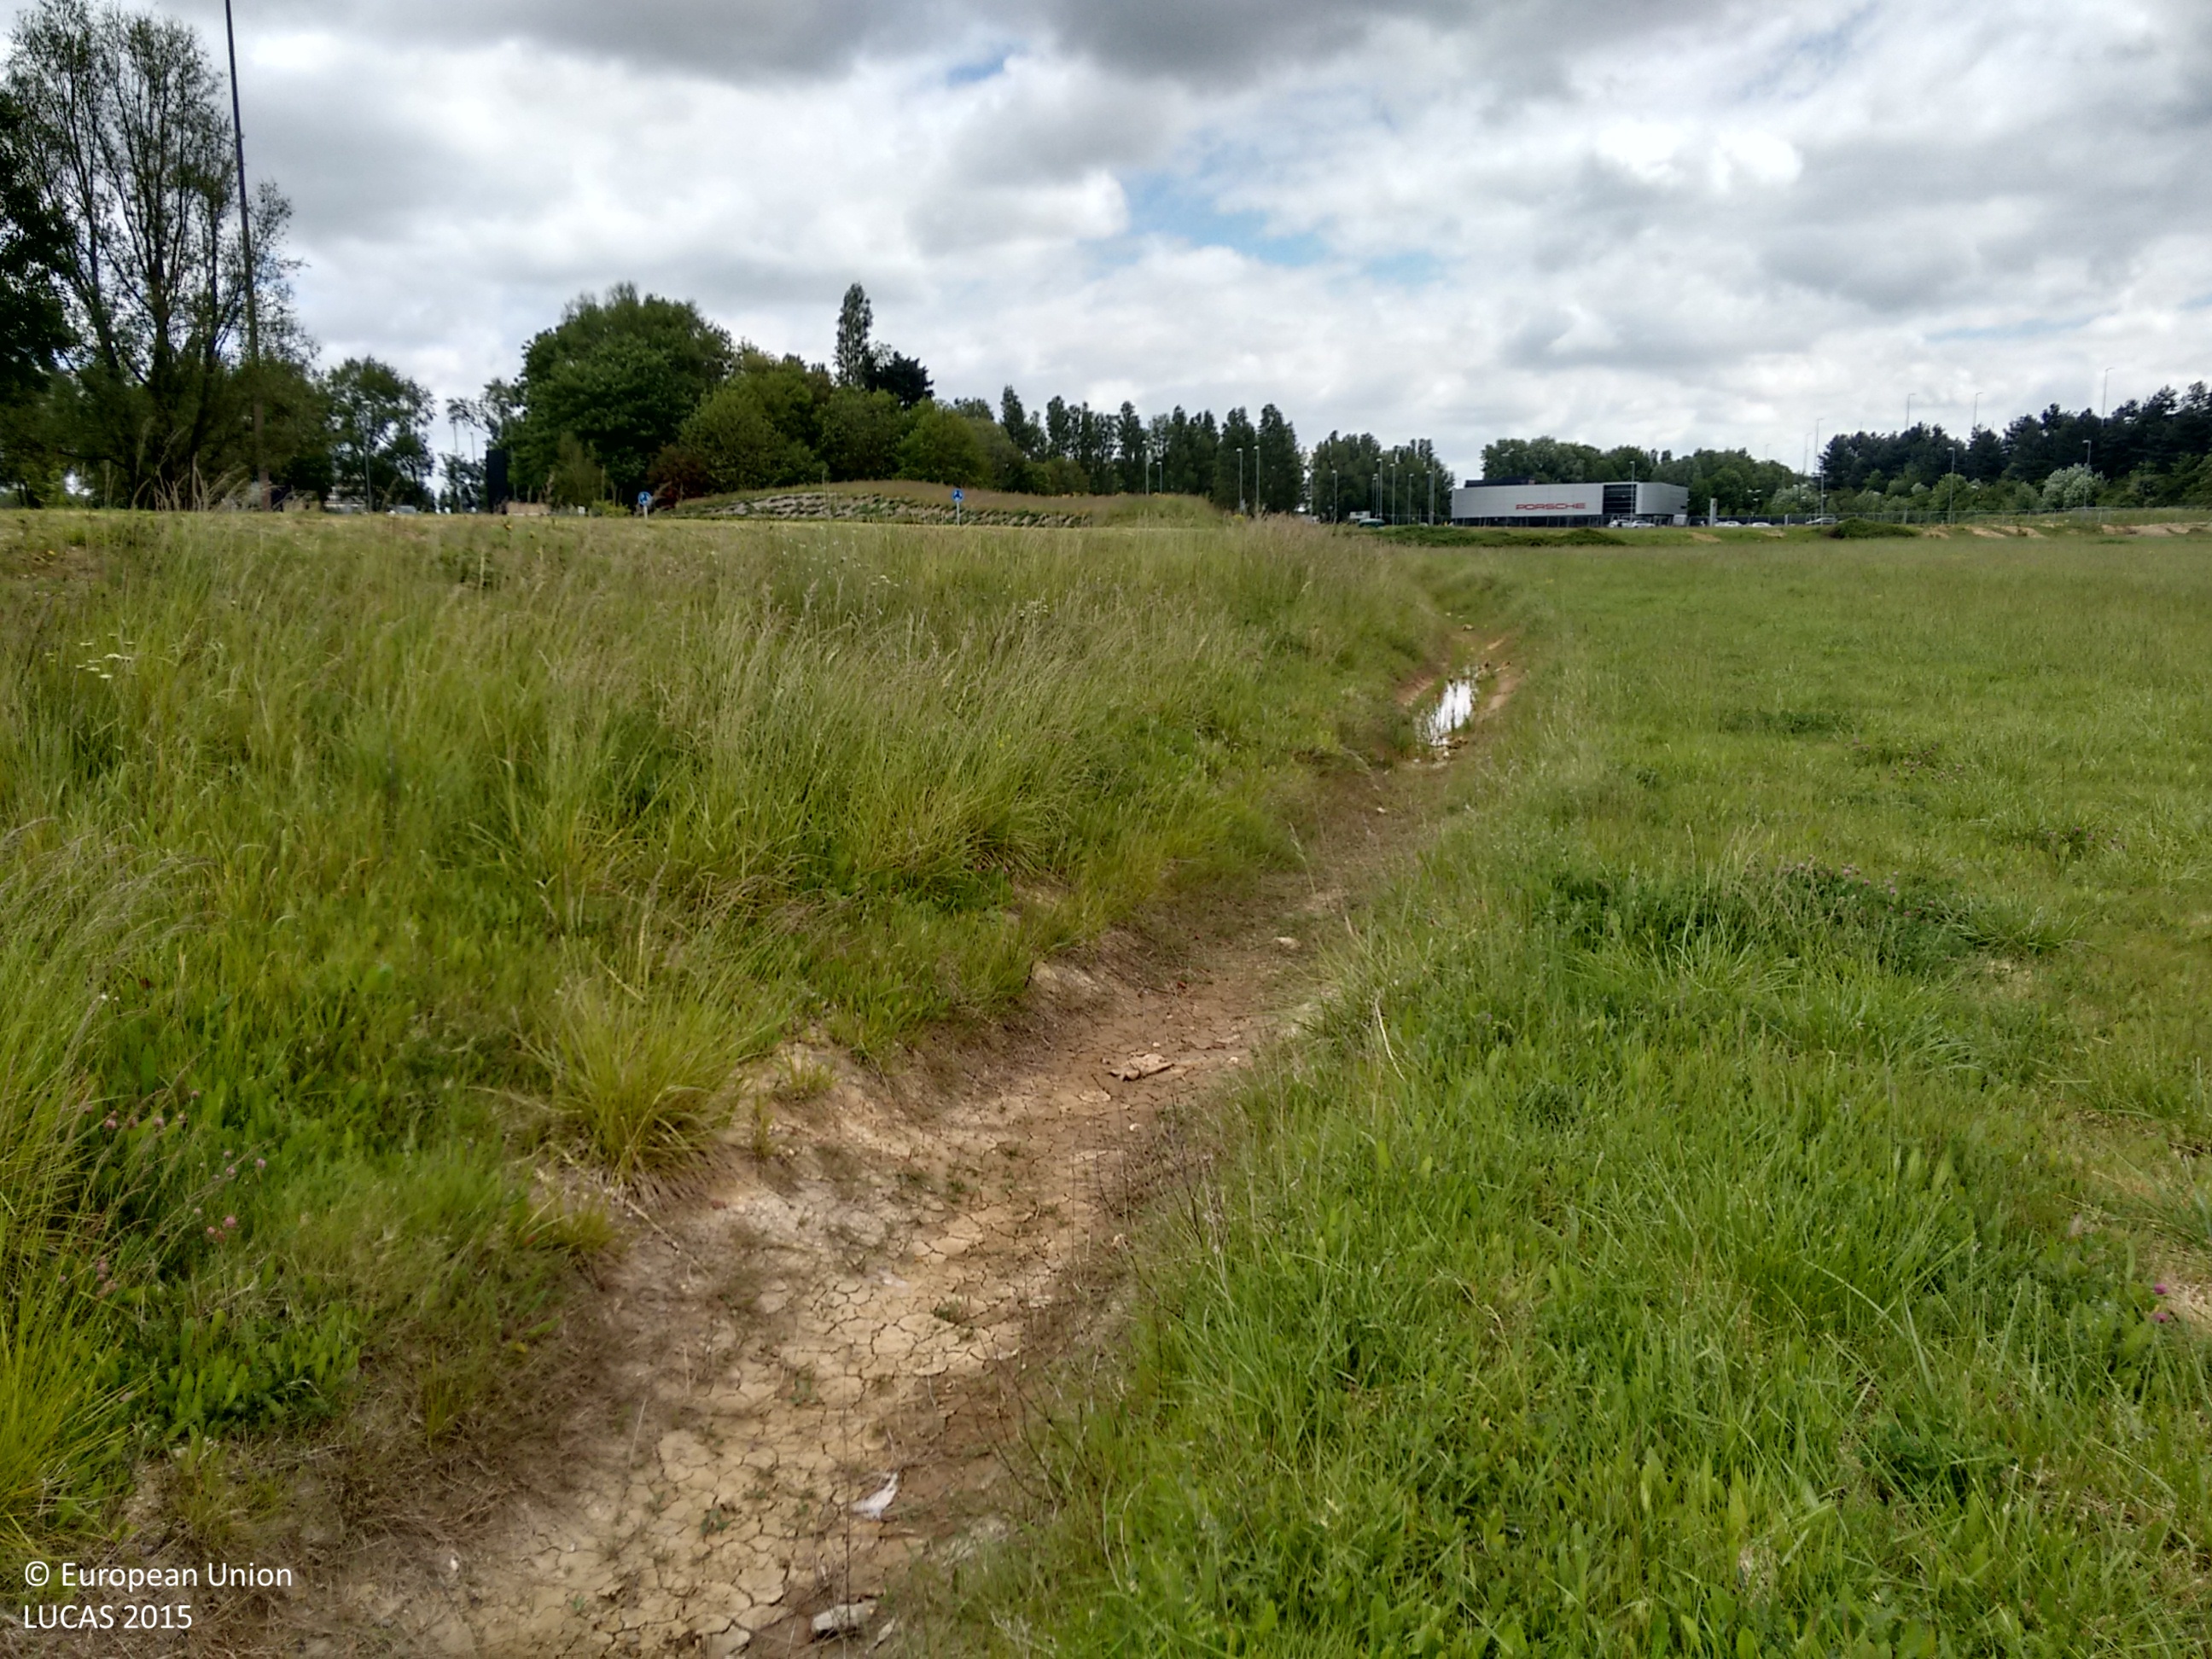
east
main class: Grassland
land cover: Grassland without tree/shrub cover
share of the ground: > 75 %
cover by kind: herbaceous plants 100 %
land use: Semi-natural and natural areas not in use
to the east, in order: Grassland without tree/shrub cover; Ditches and canals; Grassland without tree/shrub cover; Paved roads, cycling and walking lanes; Grassland without tree/shrub cover; Ditches and canals; Grassland without tree/shrub cover; Paved roads, cycling and walking lanes; Grassland without tree/shrub cover; Broadleaved woodland; Spontaneously vegetated surfaces; Paved roads, cycling and walking lanes; Broadleaved woodland
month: May
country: GB
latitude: 50.8405
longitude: -1.0795
